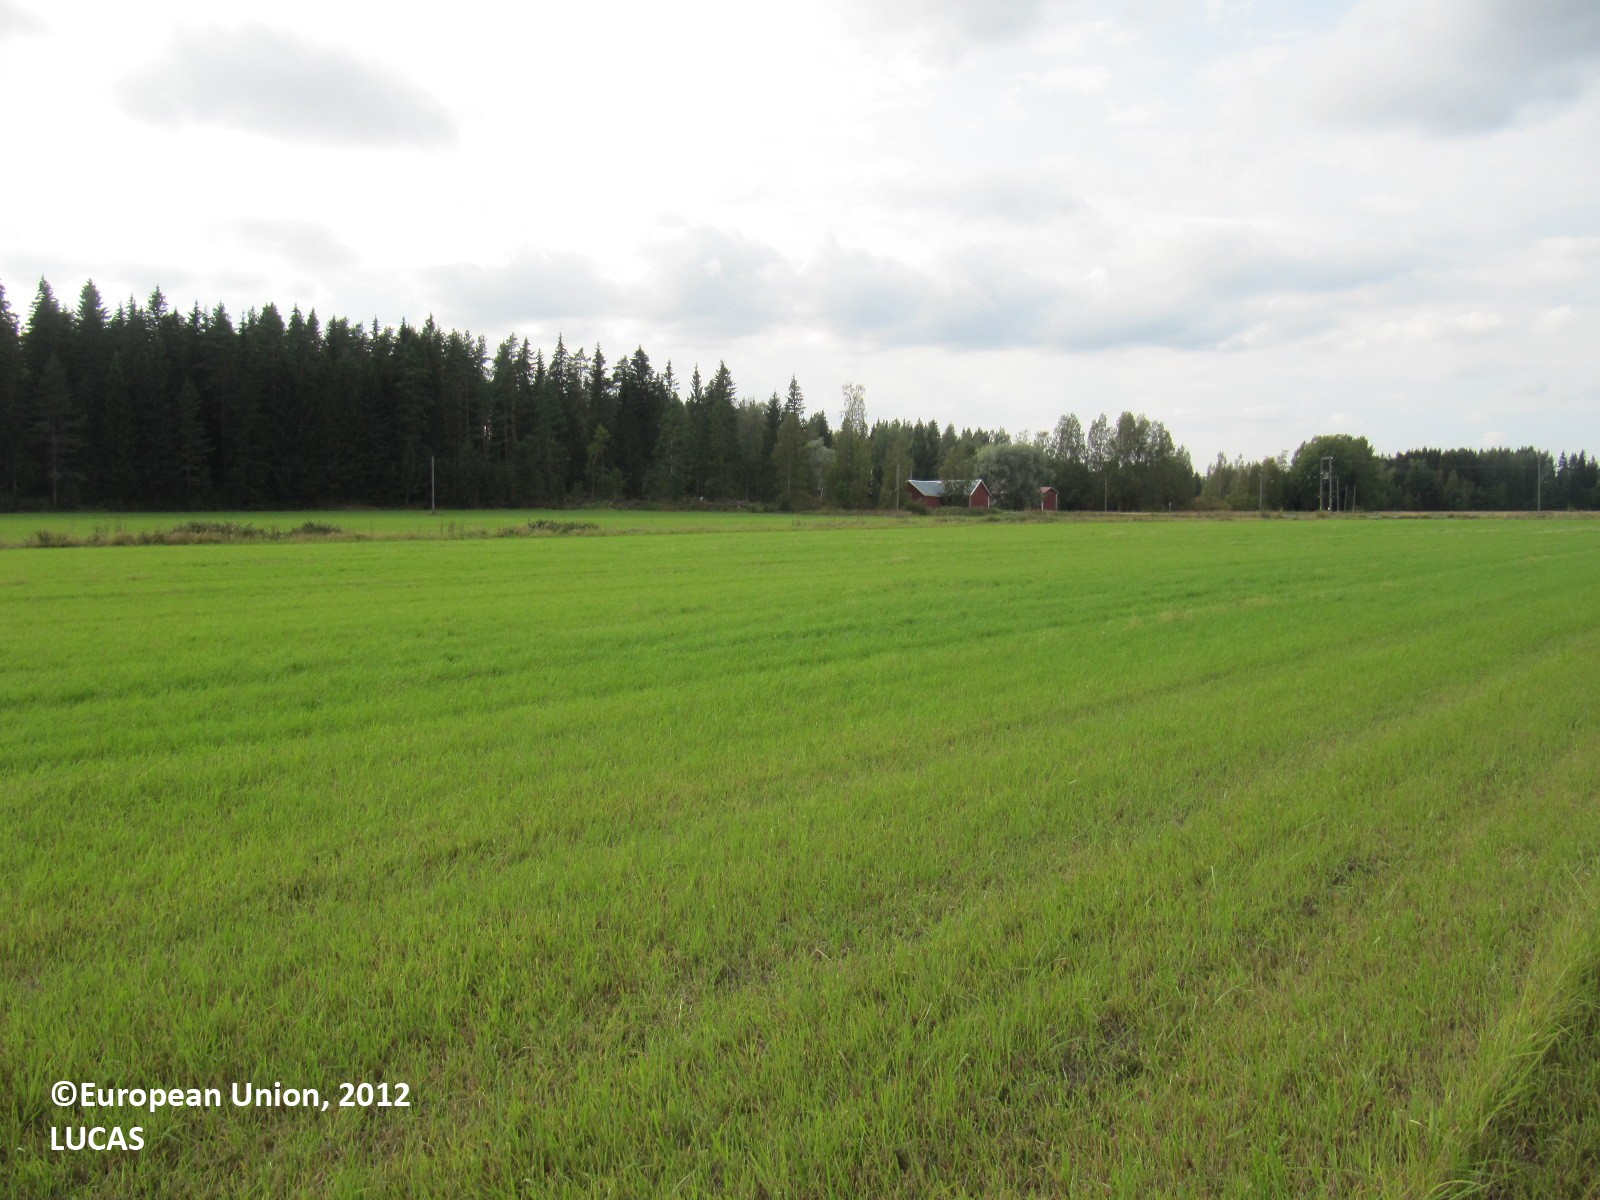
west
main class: Grassland
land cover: Spontaneously vegetated surfaces
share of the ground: > 75 %
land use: Agriculture (excluding fallow land and kitchen gardens)
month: August
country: FI
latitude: 61.0826
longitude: 22.9203
